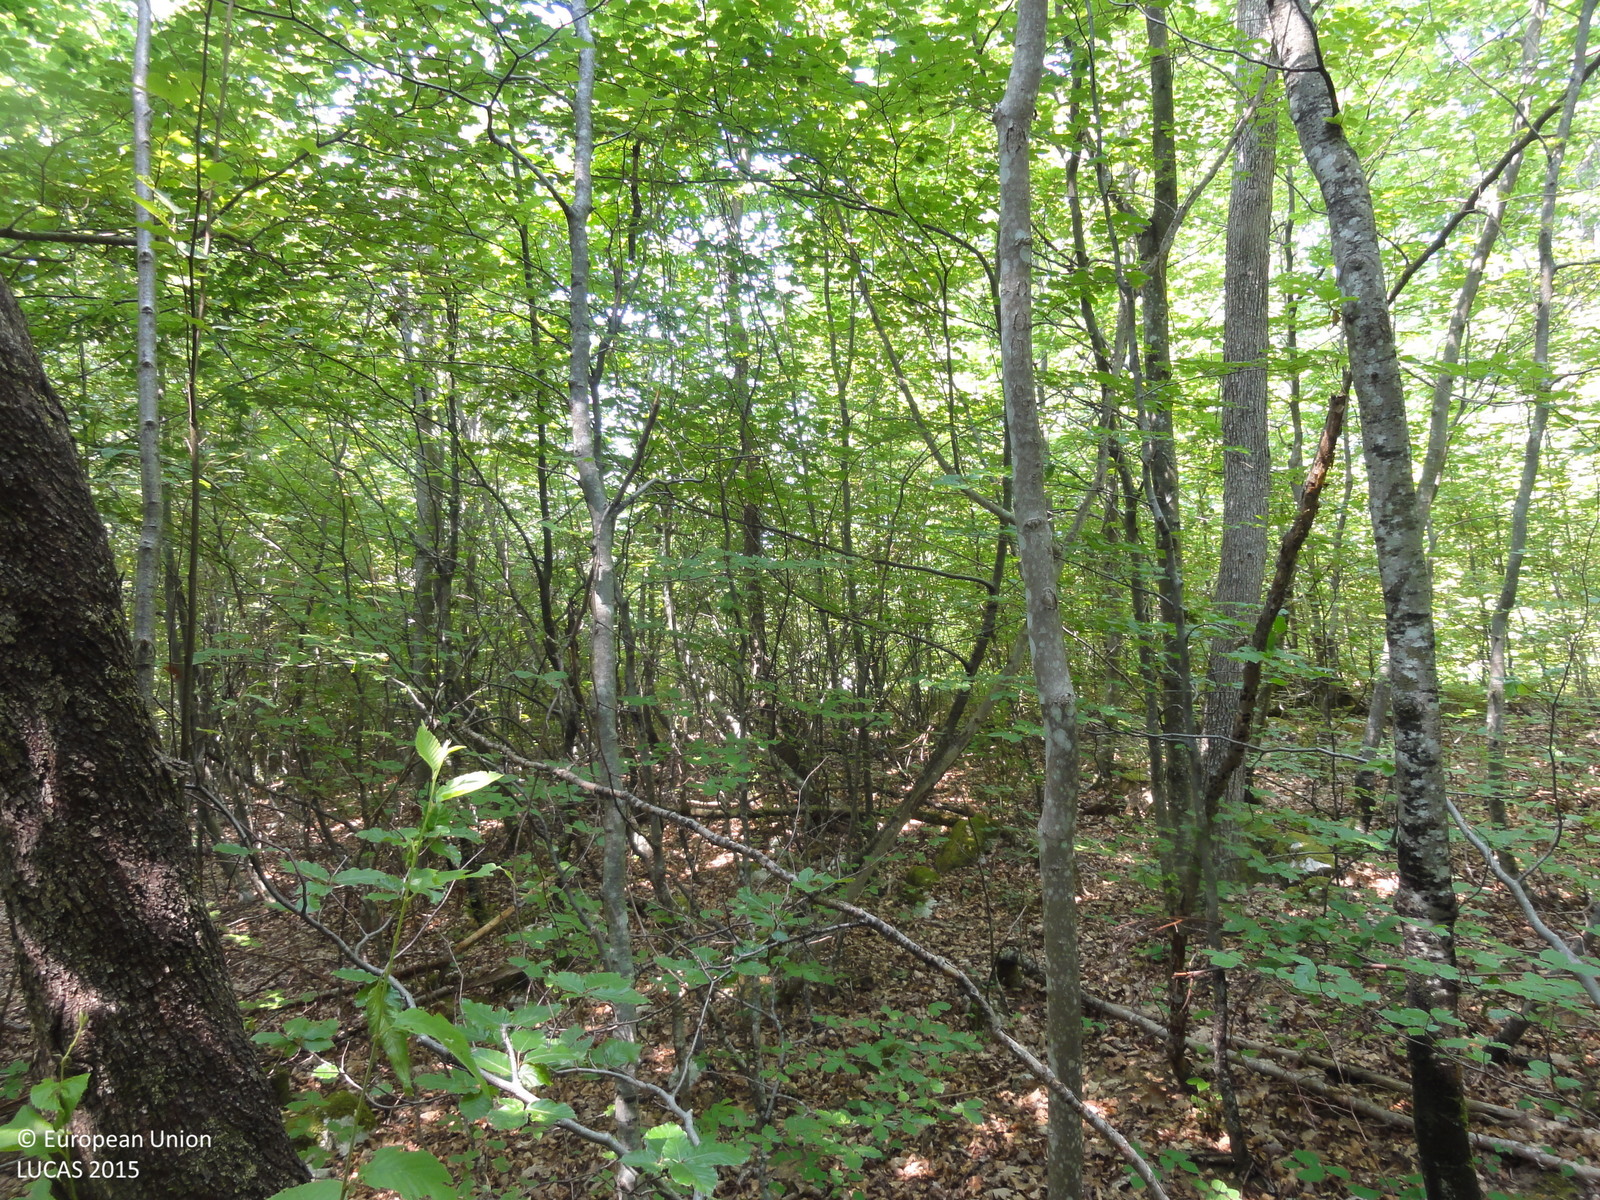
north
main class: Woodland
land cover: Broadleaved woodland
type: beech forest
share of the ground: > 75 %
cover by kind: broadleaved forest trees 100 %
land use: Forestry
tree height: > 5 m
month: July
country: SI
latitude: 45.8454
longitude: 14.8250
